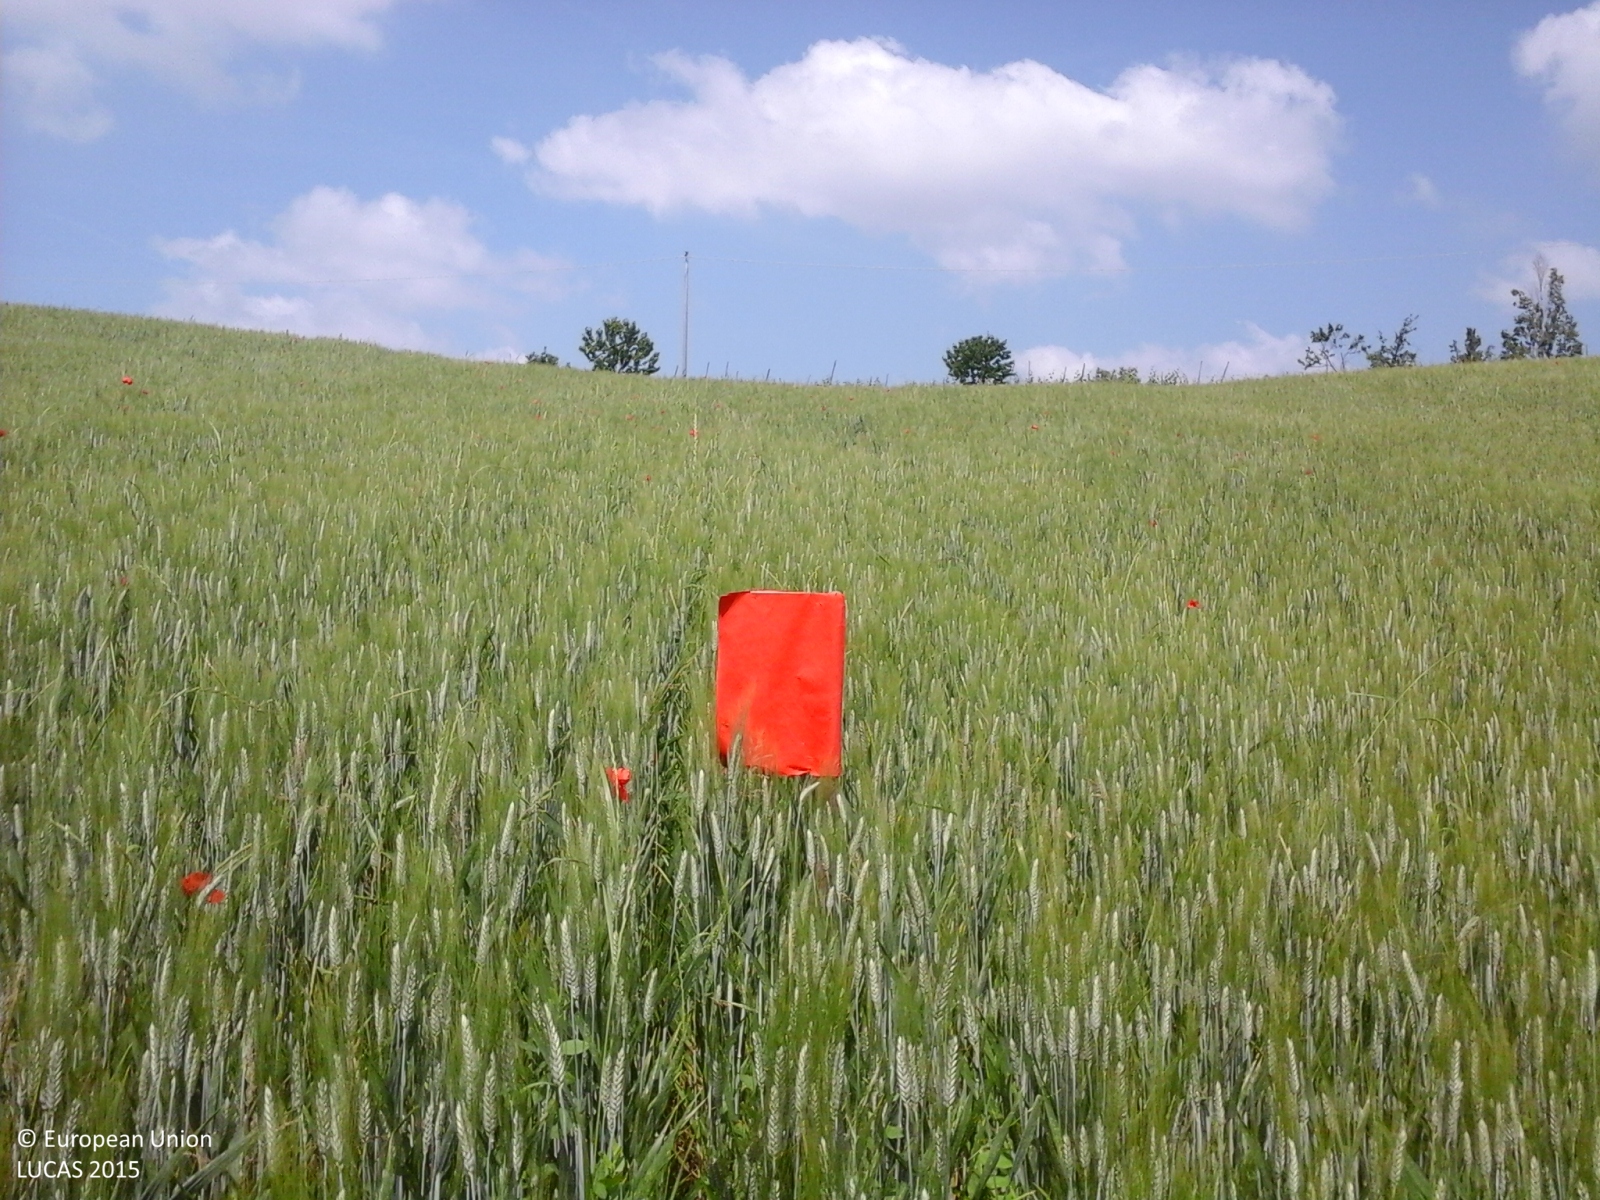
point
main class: Cropland
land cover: Common wheat
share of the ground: > 75 %
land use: Agriculture (excluding fallow land and kitchen gardens)
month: May
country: IT
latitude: 44.6930
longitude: 10.2141
